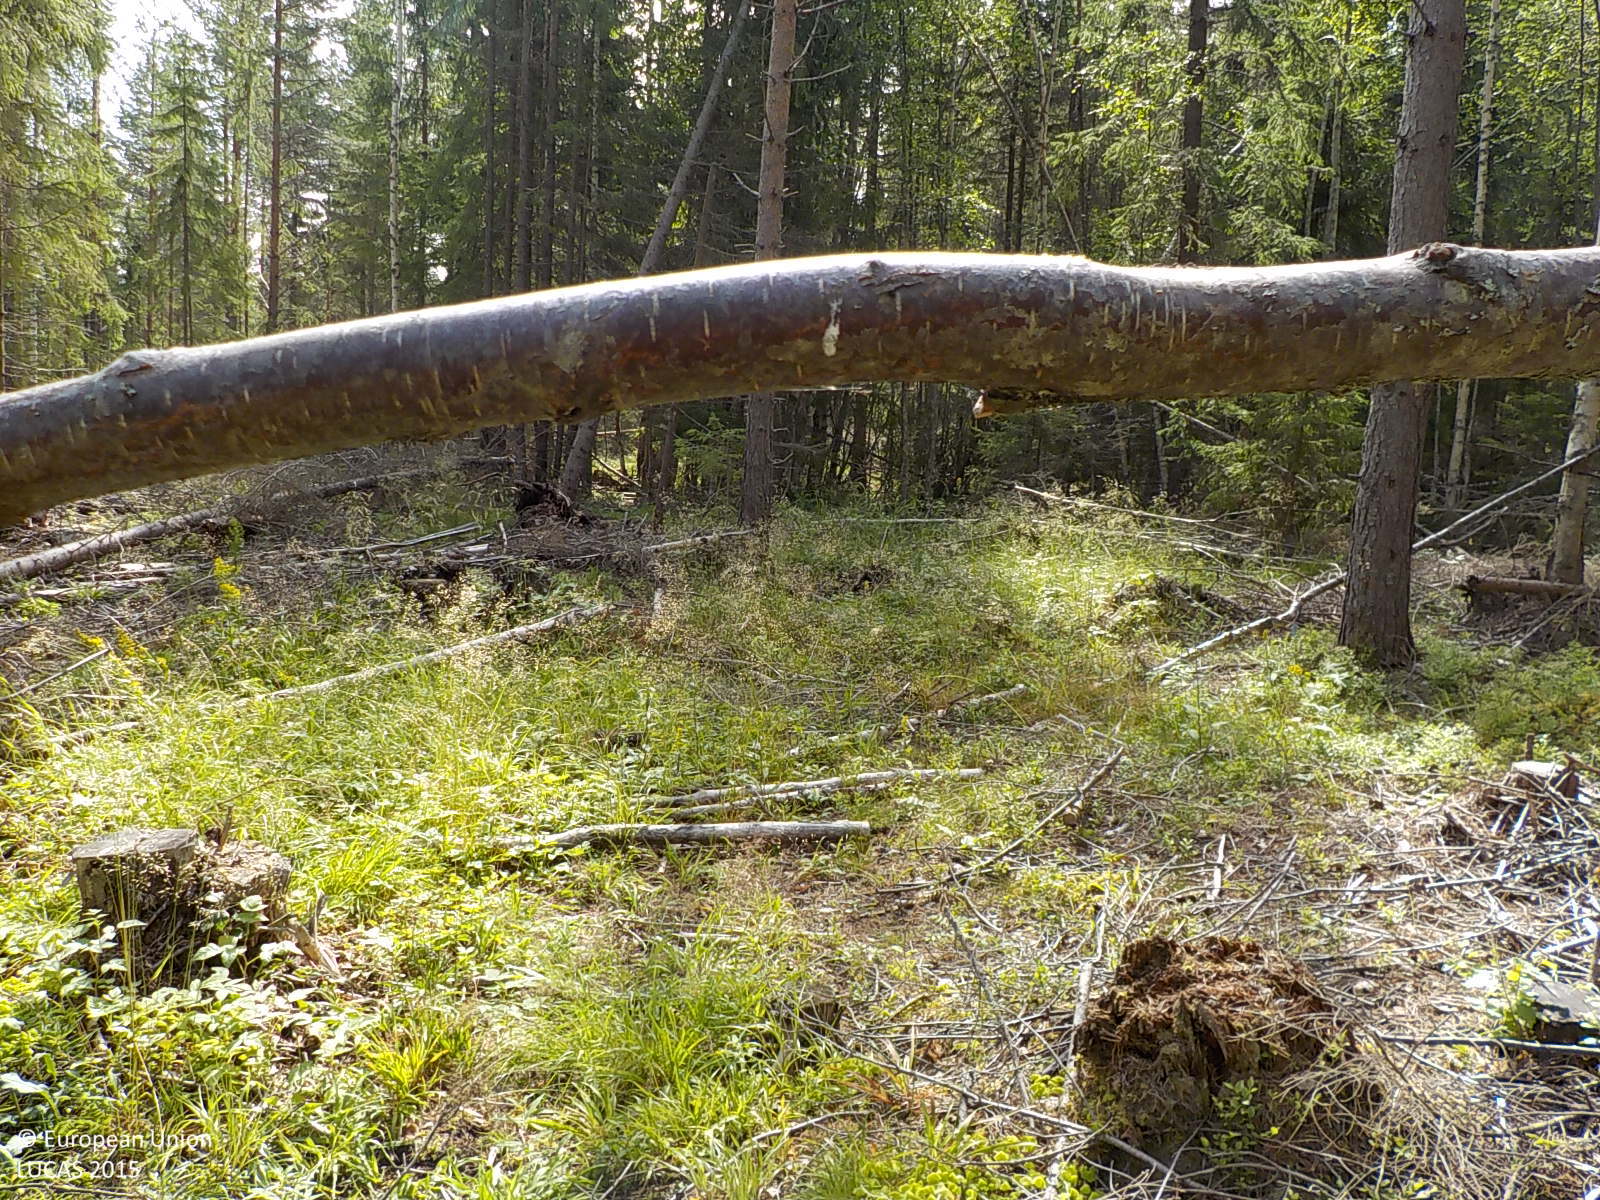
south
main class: Woodland
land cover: Pine dominated coniferous woodland
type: boreal forest
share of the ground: 50 - 75 %
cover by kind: coniferous forest trees 70 %, herbaceous plants 10 %, broadleaved forest trees 5 %, shrubs 5 %
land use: Forestry
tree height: > 5 m
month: July
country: SE
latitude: 63.1940
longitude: 17.3496
